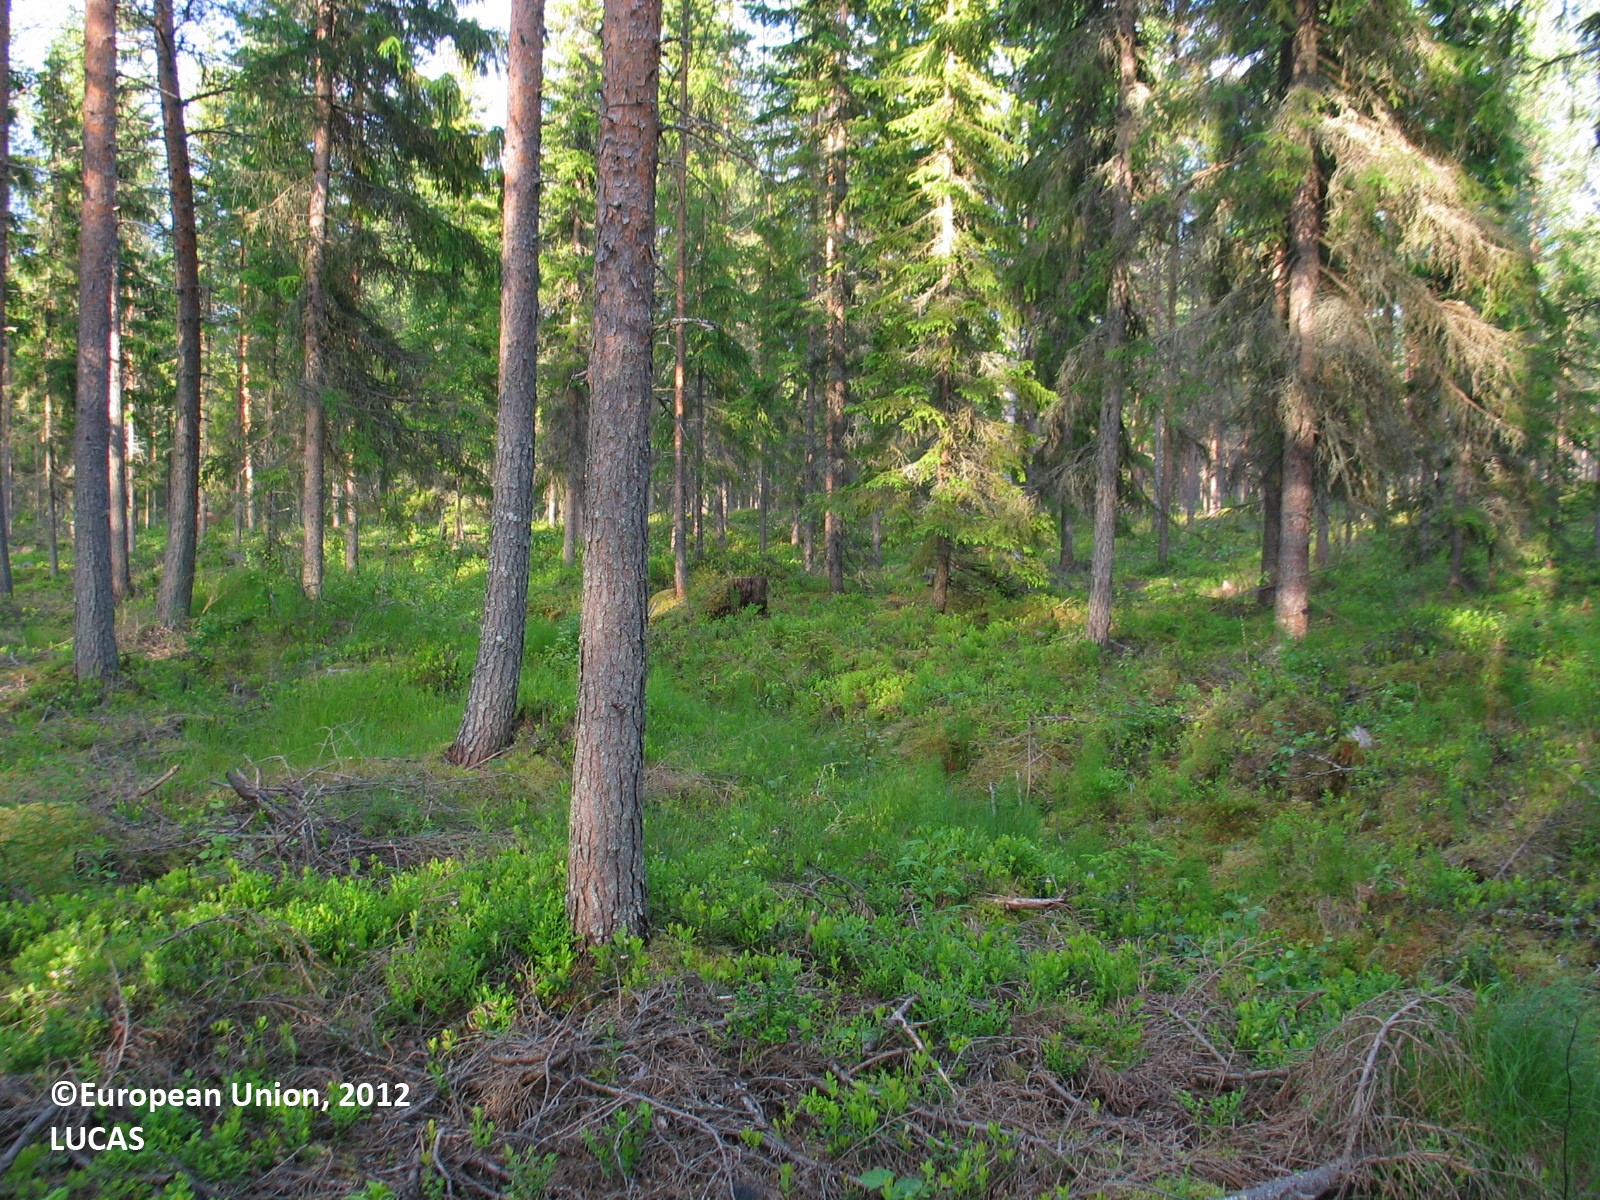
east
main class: Woodland
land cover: Other coniferous woodland
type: boreal forest
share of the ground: 25 - 50 %
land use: Forestry
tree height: > 5 m
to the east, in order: Other coniferous woodland; Ditches and canals; Other coniferous woodland; Ditches and canals; Other coniferous woodland; Pine dominated coniferous woodland; Tracks; Pine dominated coniferous woodland
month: June
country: FI
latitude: 64.9479
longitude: 26.5558
